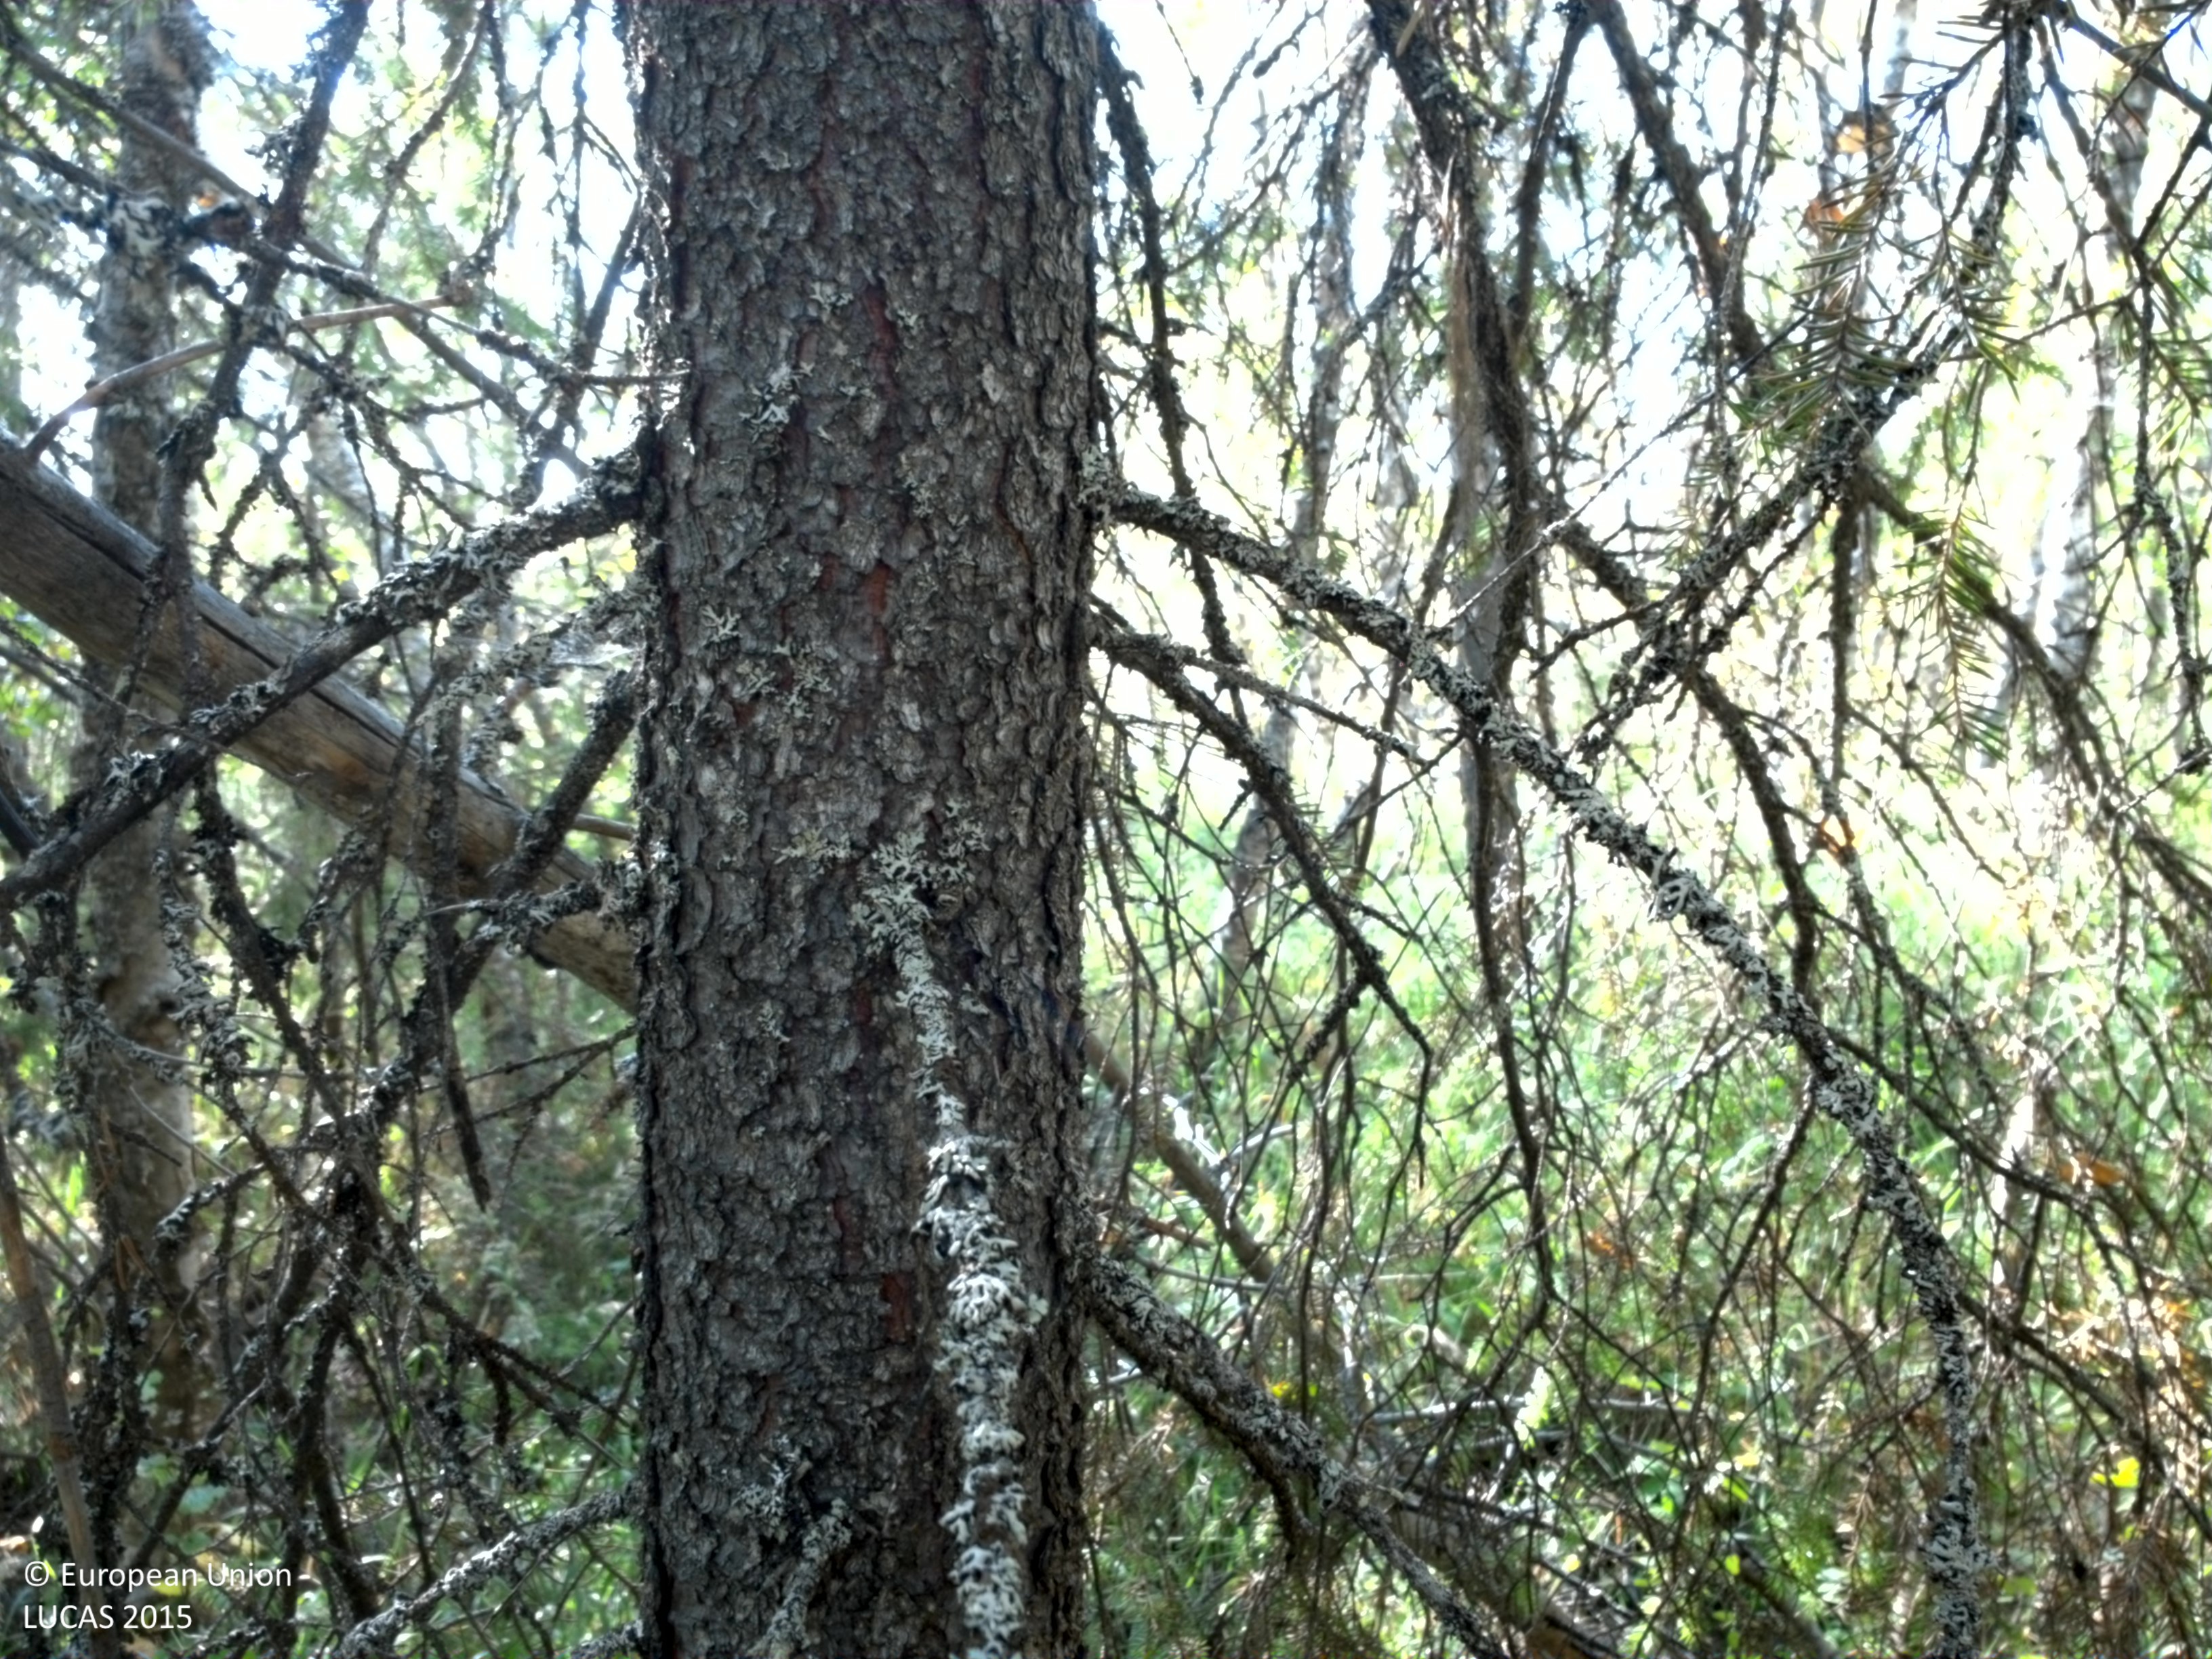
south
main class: Woodland
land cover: Broadleaved woodland
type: non-riverine alder, birch or aspen forest
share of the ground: 50 - 75 %
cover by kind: broadleaved forest trees 55 %, shrubs 15 %, herbaceous plants 15 %, coniferous forest trees 10 %, lichens and mosses 5 %
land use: Forestry
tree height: > 5 m
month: August
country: SE
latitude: 66.7605
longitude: 20.9707
